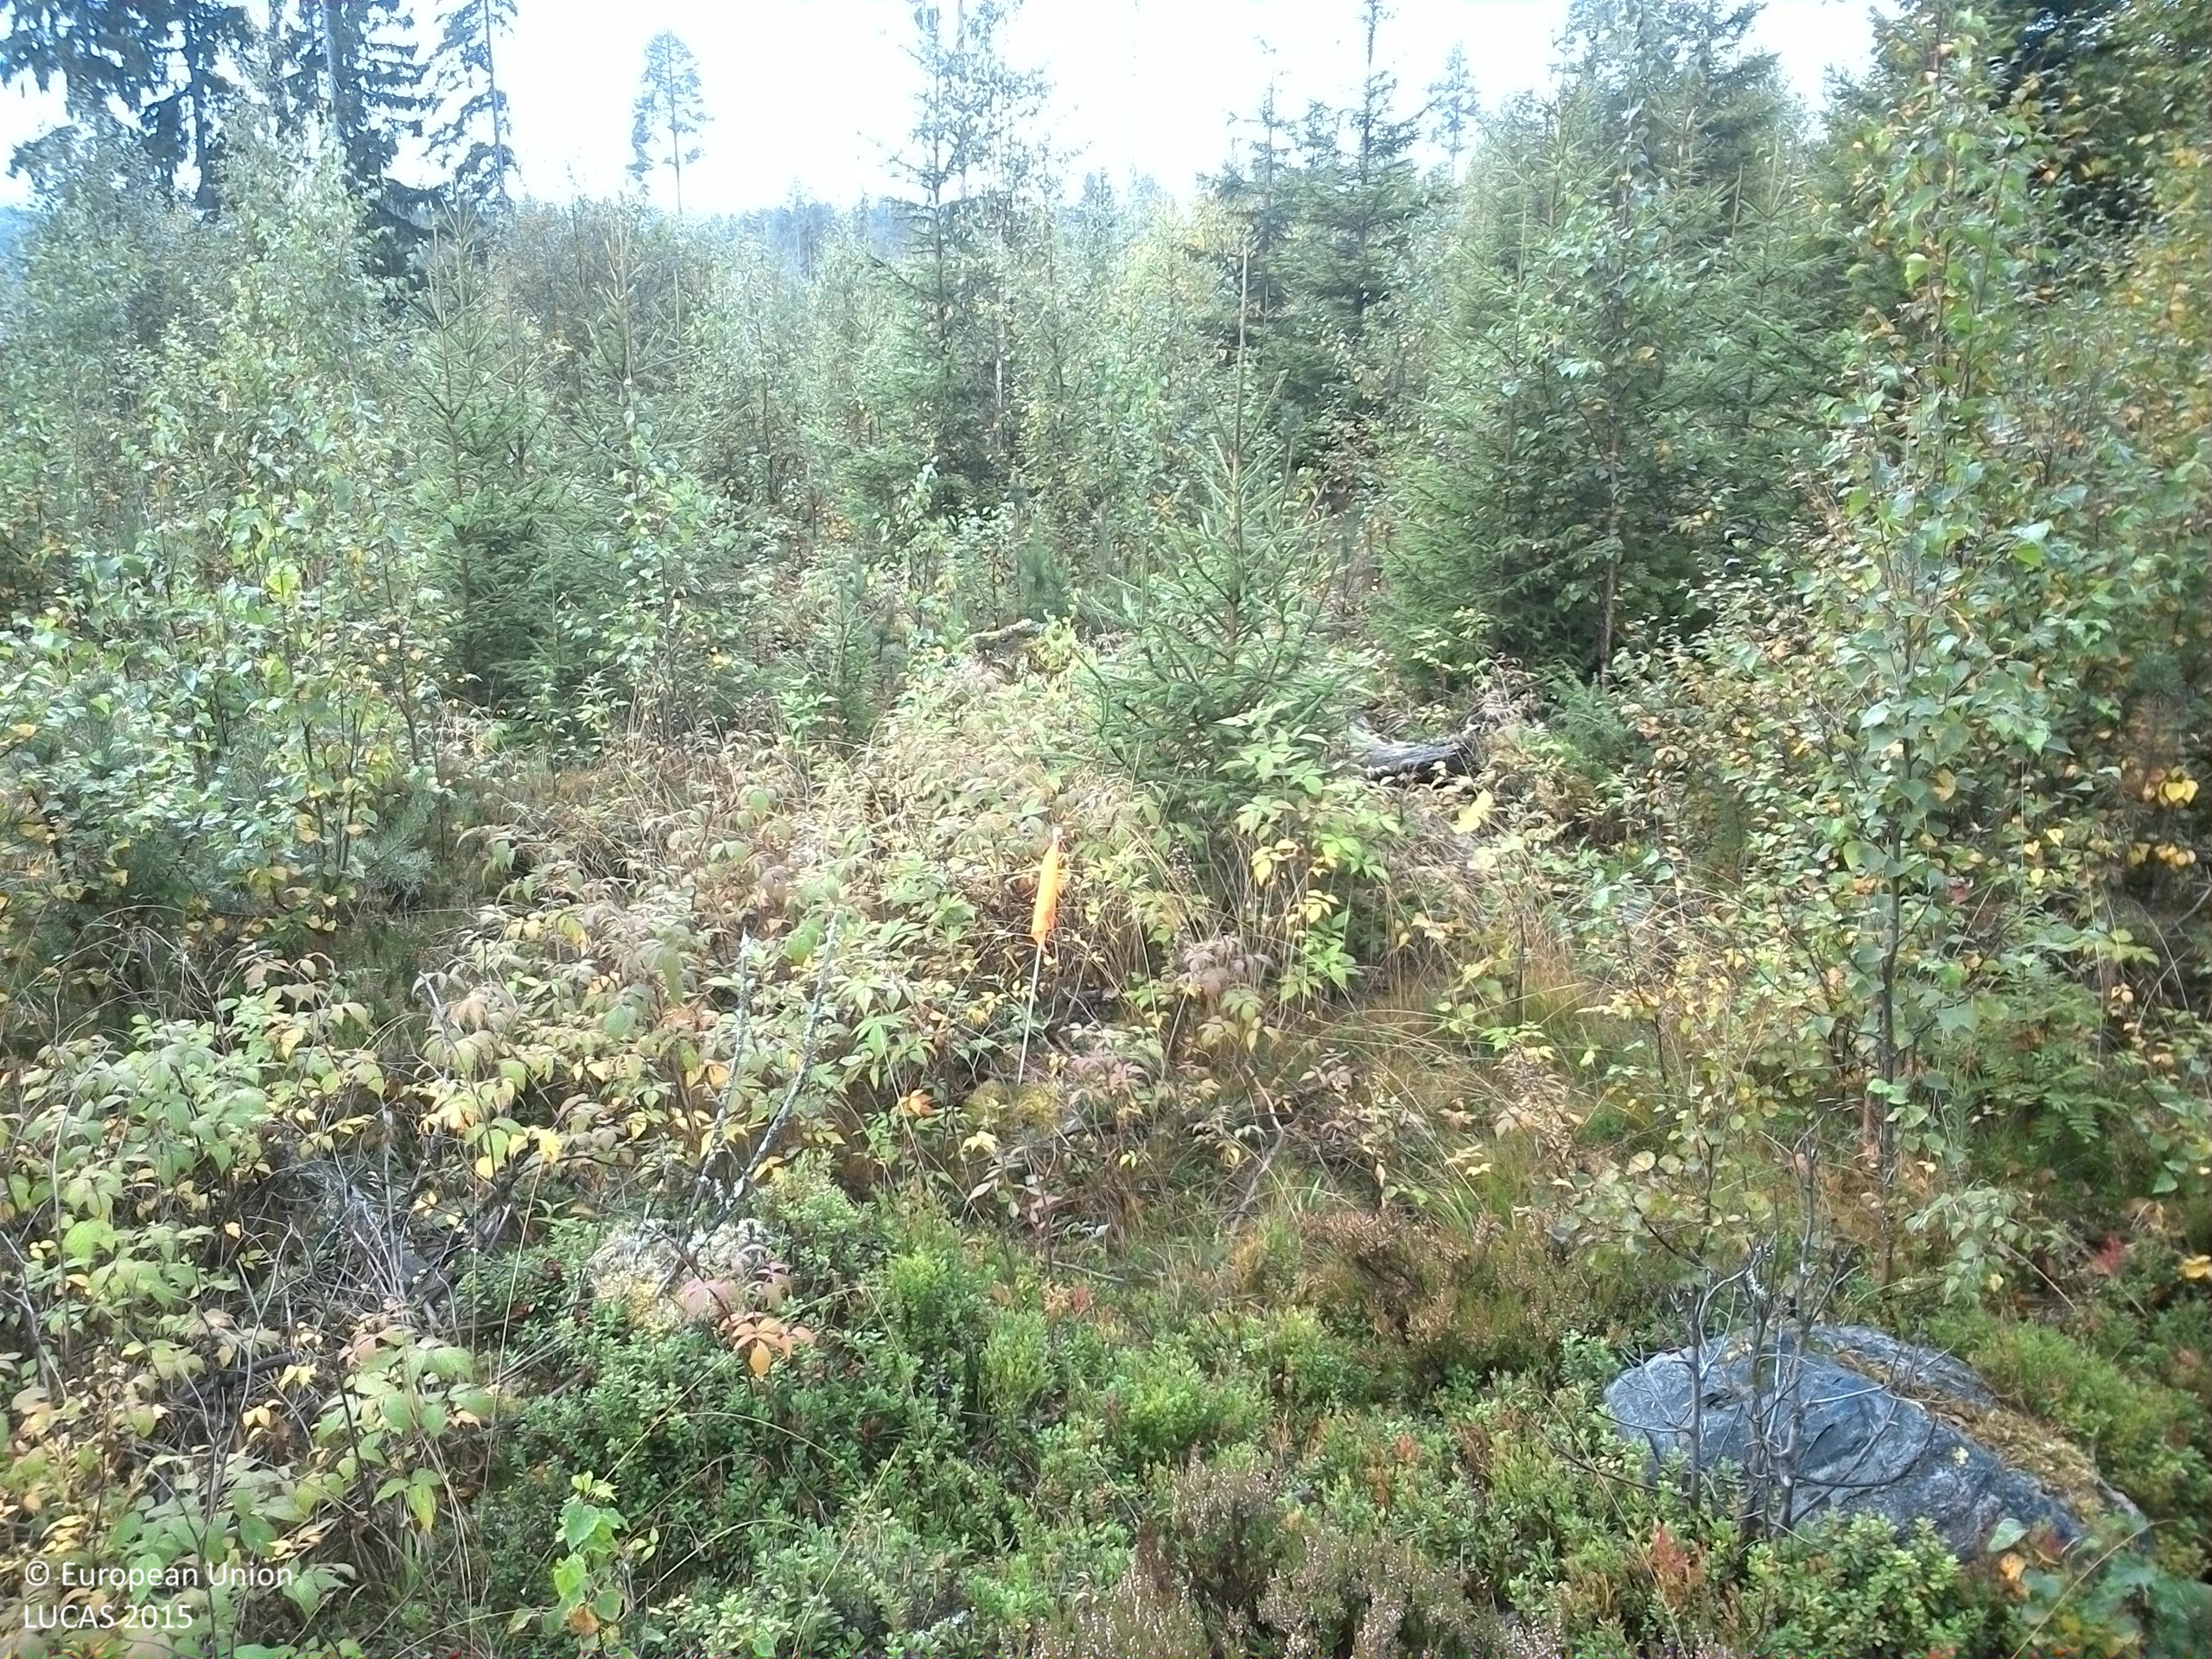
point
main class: Woodland
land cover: Other mixed woodland
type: boreal forest
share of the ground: 50 - 75 %
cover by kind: coniferous forest trees 30 %, broadleaved forest trees 30 %, shrubs 20 %, herbaceous plants 10 %, lichens and mosses 10 %
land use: Forestry
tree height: < 5 m
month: September
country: SE
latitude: 61.6383
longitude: 15.1730
